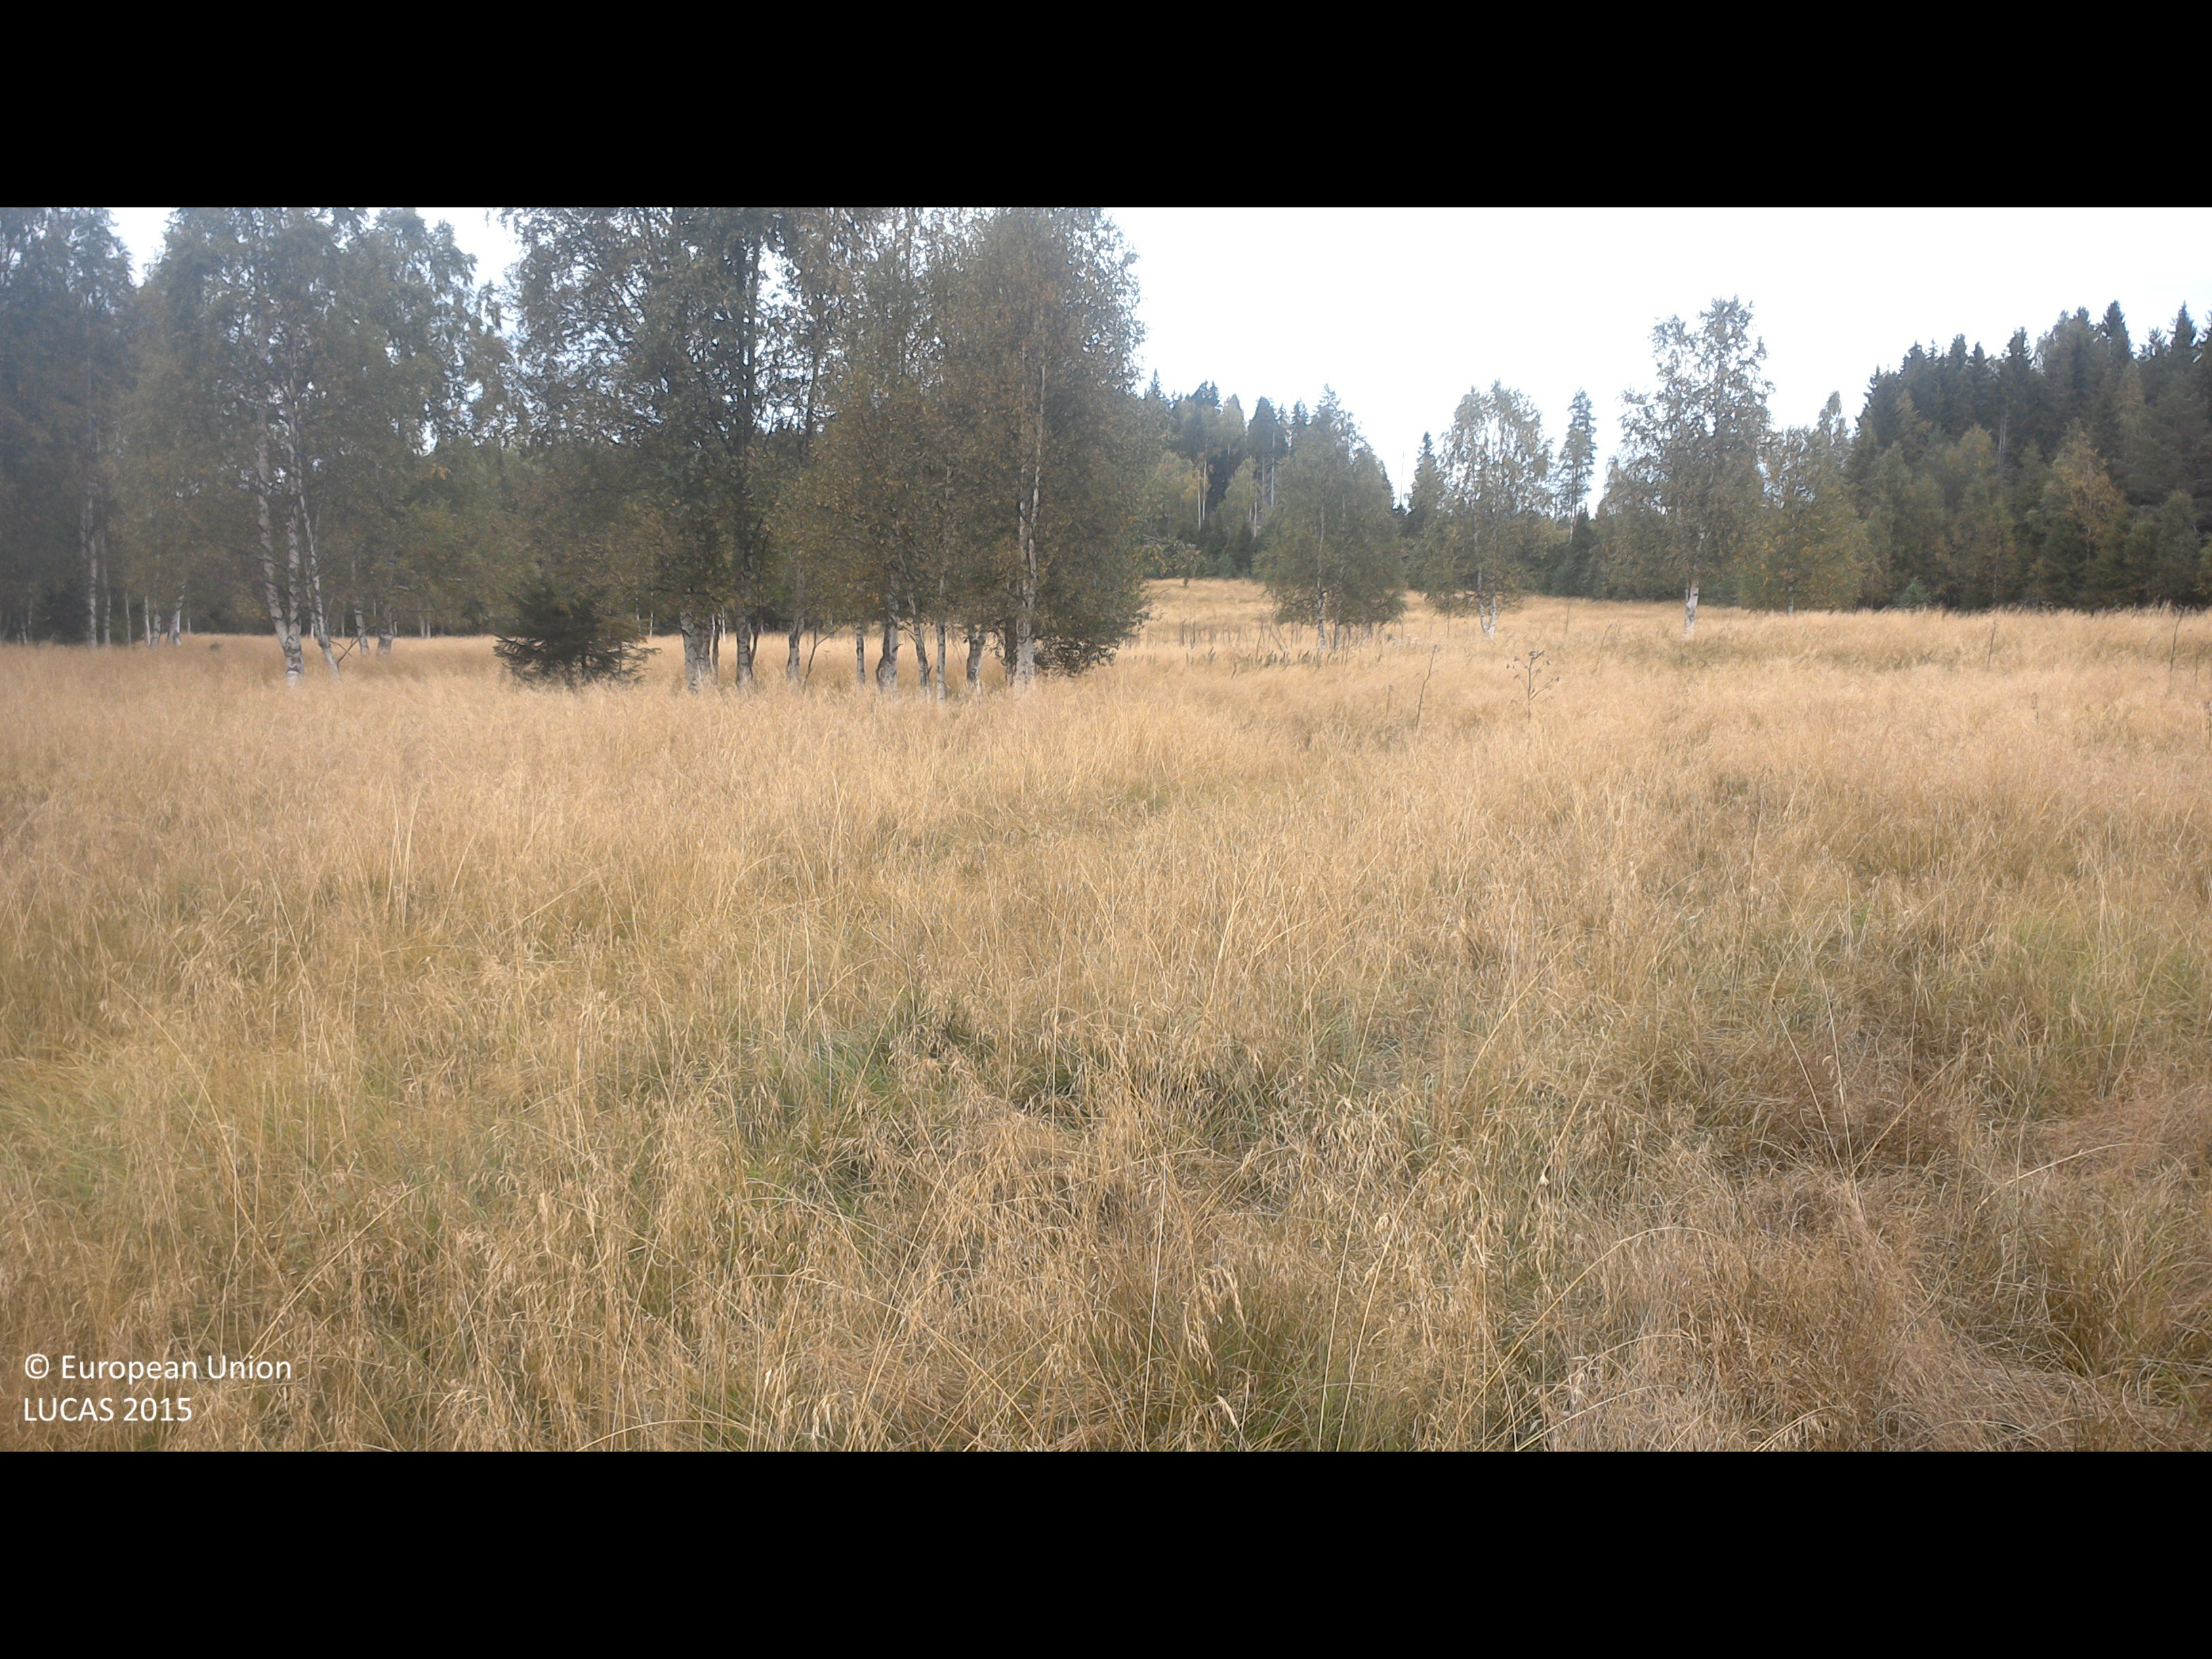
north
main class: Grassland
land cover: Grassland without tree/shrub cover
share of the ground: > 75 %
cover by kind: herbaceous plants 100 %
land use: Agriculture (excluding fallow land and kitchen gardens)
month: September
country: SE
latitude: 63.7807
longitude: 19.5739
